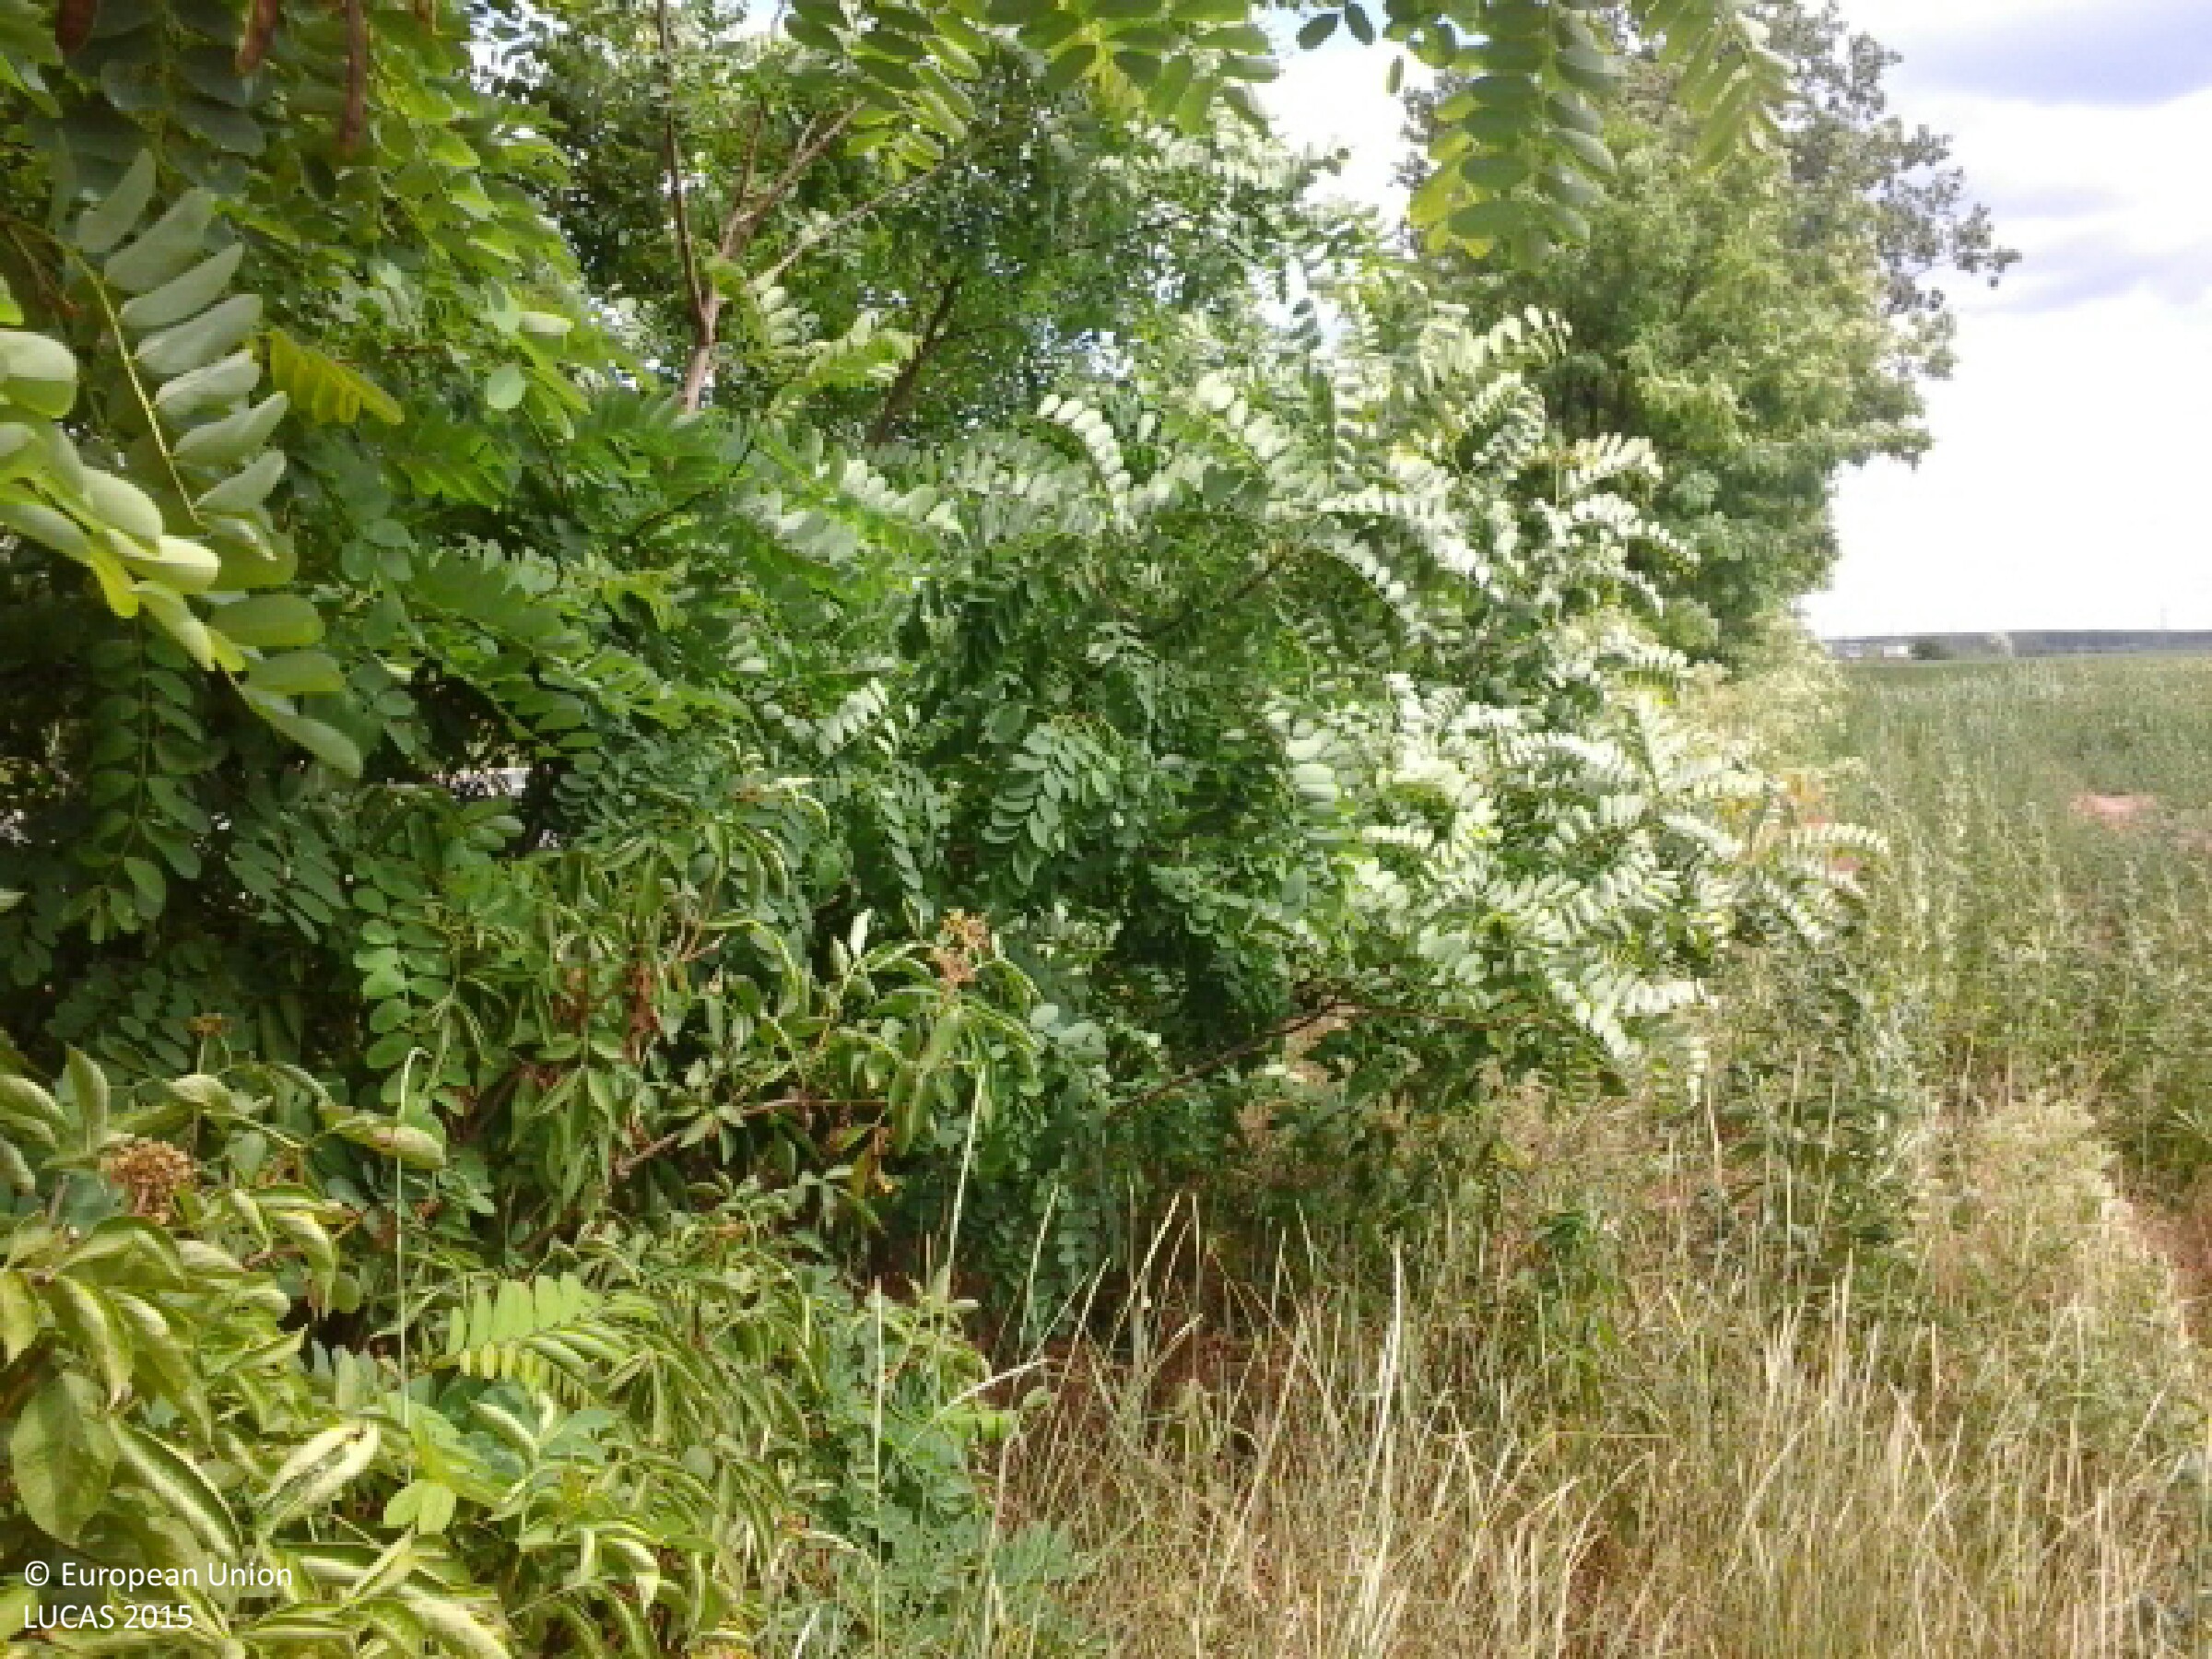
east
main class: Shrubland
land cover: Shrubland with sparse tree cover
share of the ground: 50 - 75 %
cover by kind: shrubs 70 %, herbaceous plants 25 %, broadleaved forest trees 5 %
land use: Road transport
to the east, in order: Shrubland with sparse tree cover; Ditches and canals; Paved roads, cycling and walking lanes; Ditches and canals; Grassland with sparse tree/shrub cover; Rye; Grassland without tree/shrub cover; Electric lines; Railways; Electric lines; Broadleaved woodland; Tracks; Maize
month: June
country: HU
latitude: 48.0717
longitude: 21.5208
